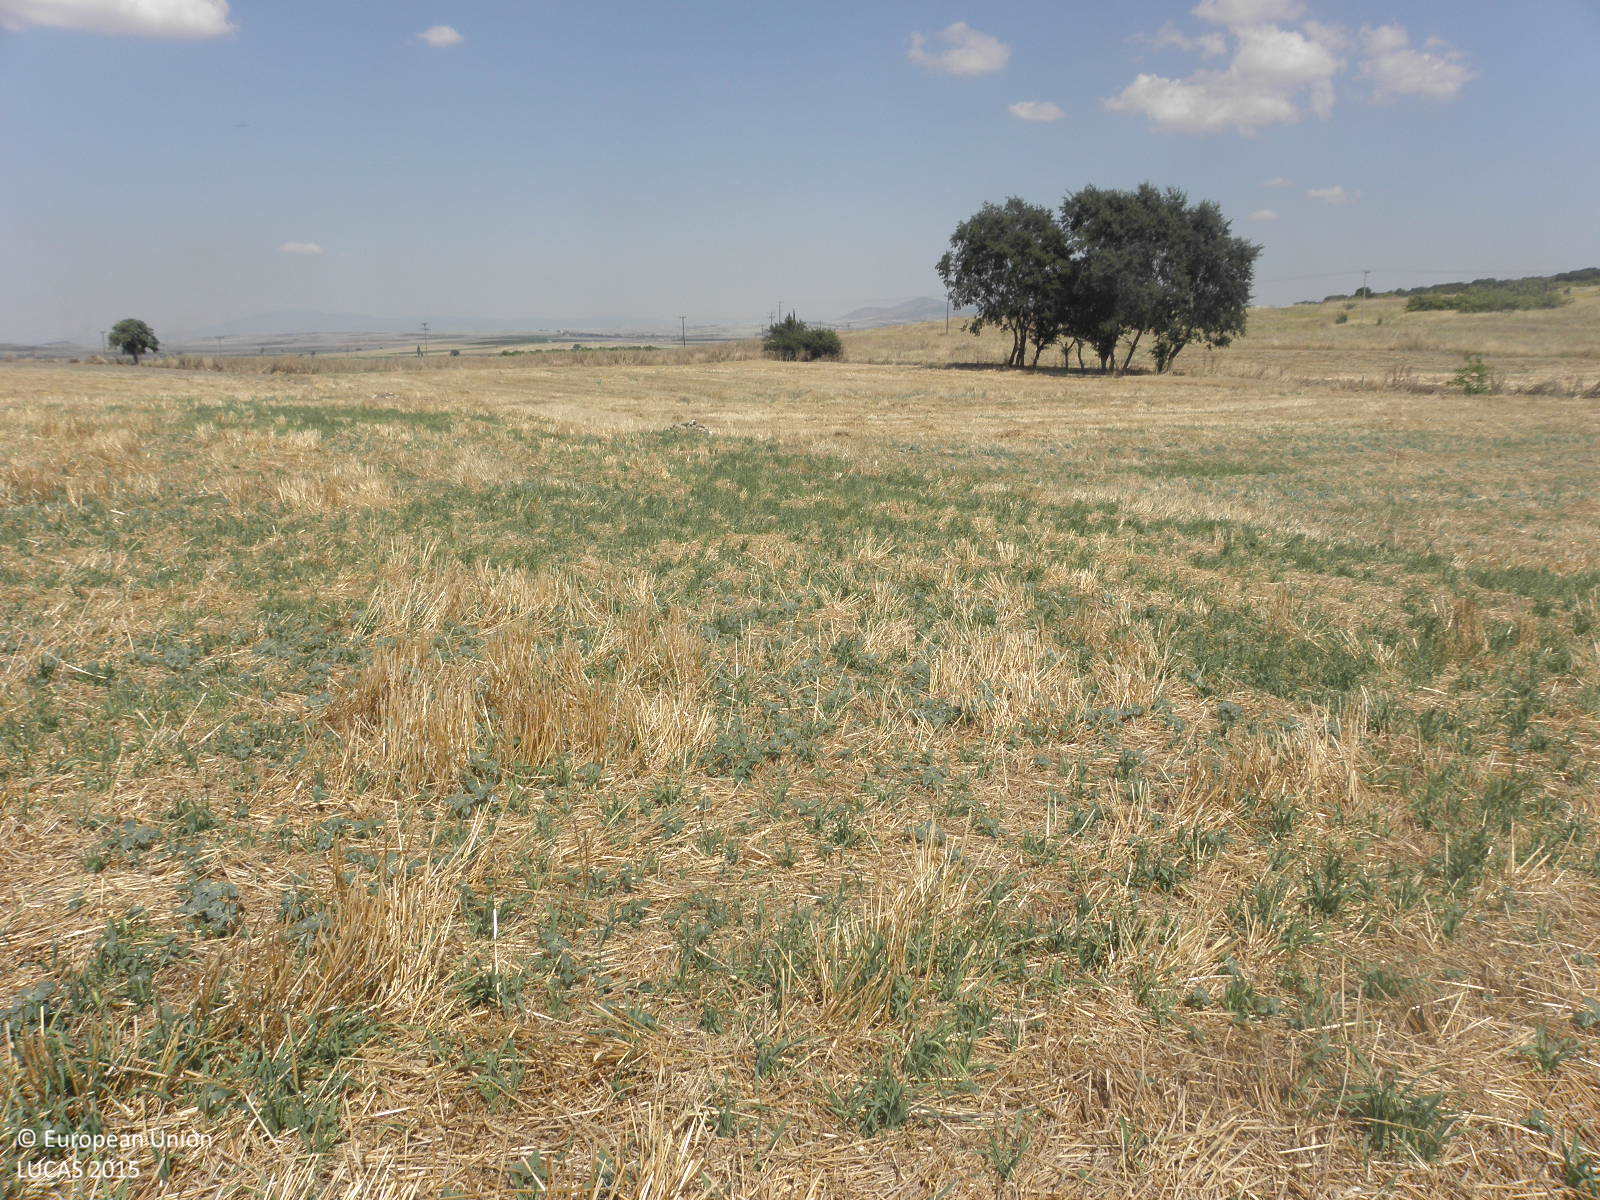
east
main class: Cropland
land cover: Durum wheat
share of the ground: > 75 %
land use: Agriculture (excluding fallow land and kitchen gardens)
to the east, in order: Durum wheat; Shruby margins; Ditches and canals; Single bushes/trees; Durum wheat; Grassland without tree/shrub cover
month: July
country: GR
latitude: 39.4457
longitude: 22.3621
